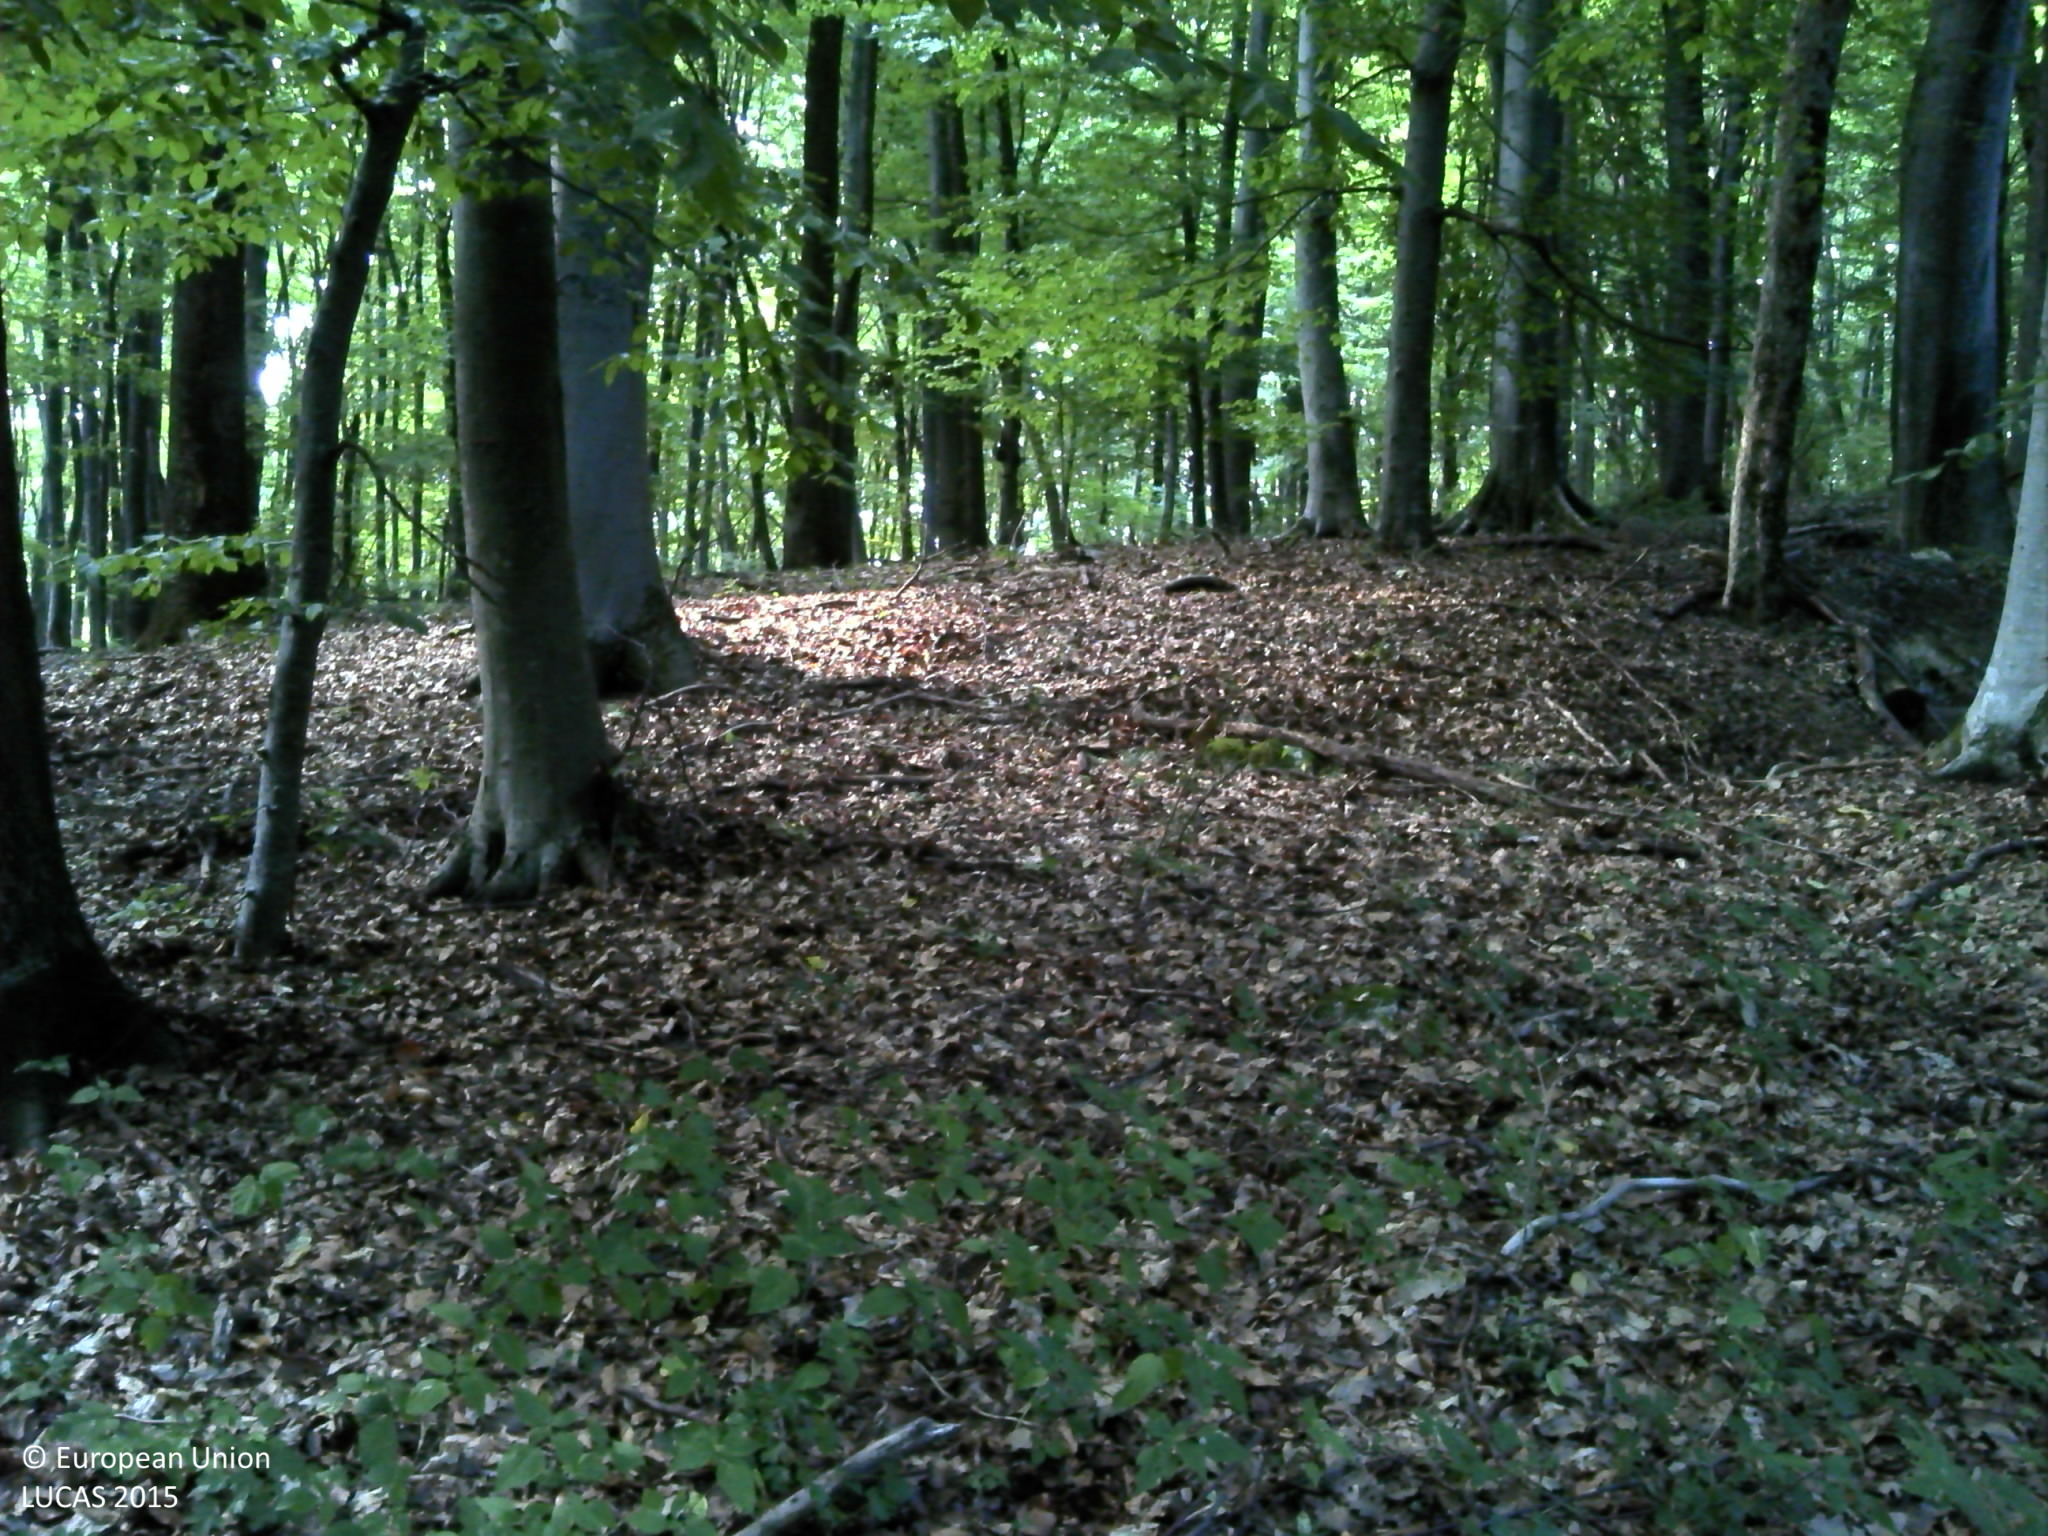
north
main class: Woodland
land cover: Broadleaved woodland
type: beech forest
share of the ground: > 75 %
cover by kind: broadleaved forest trees 100 %
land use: Forestry
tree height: > 5 m
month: July
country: HR
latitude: 45.5973
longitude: 17.2698
